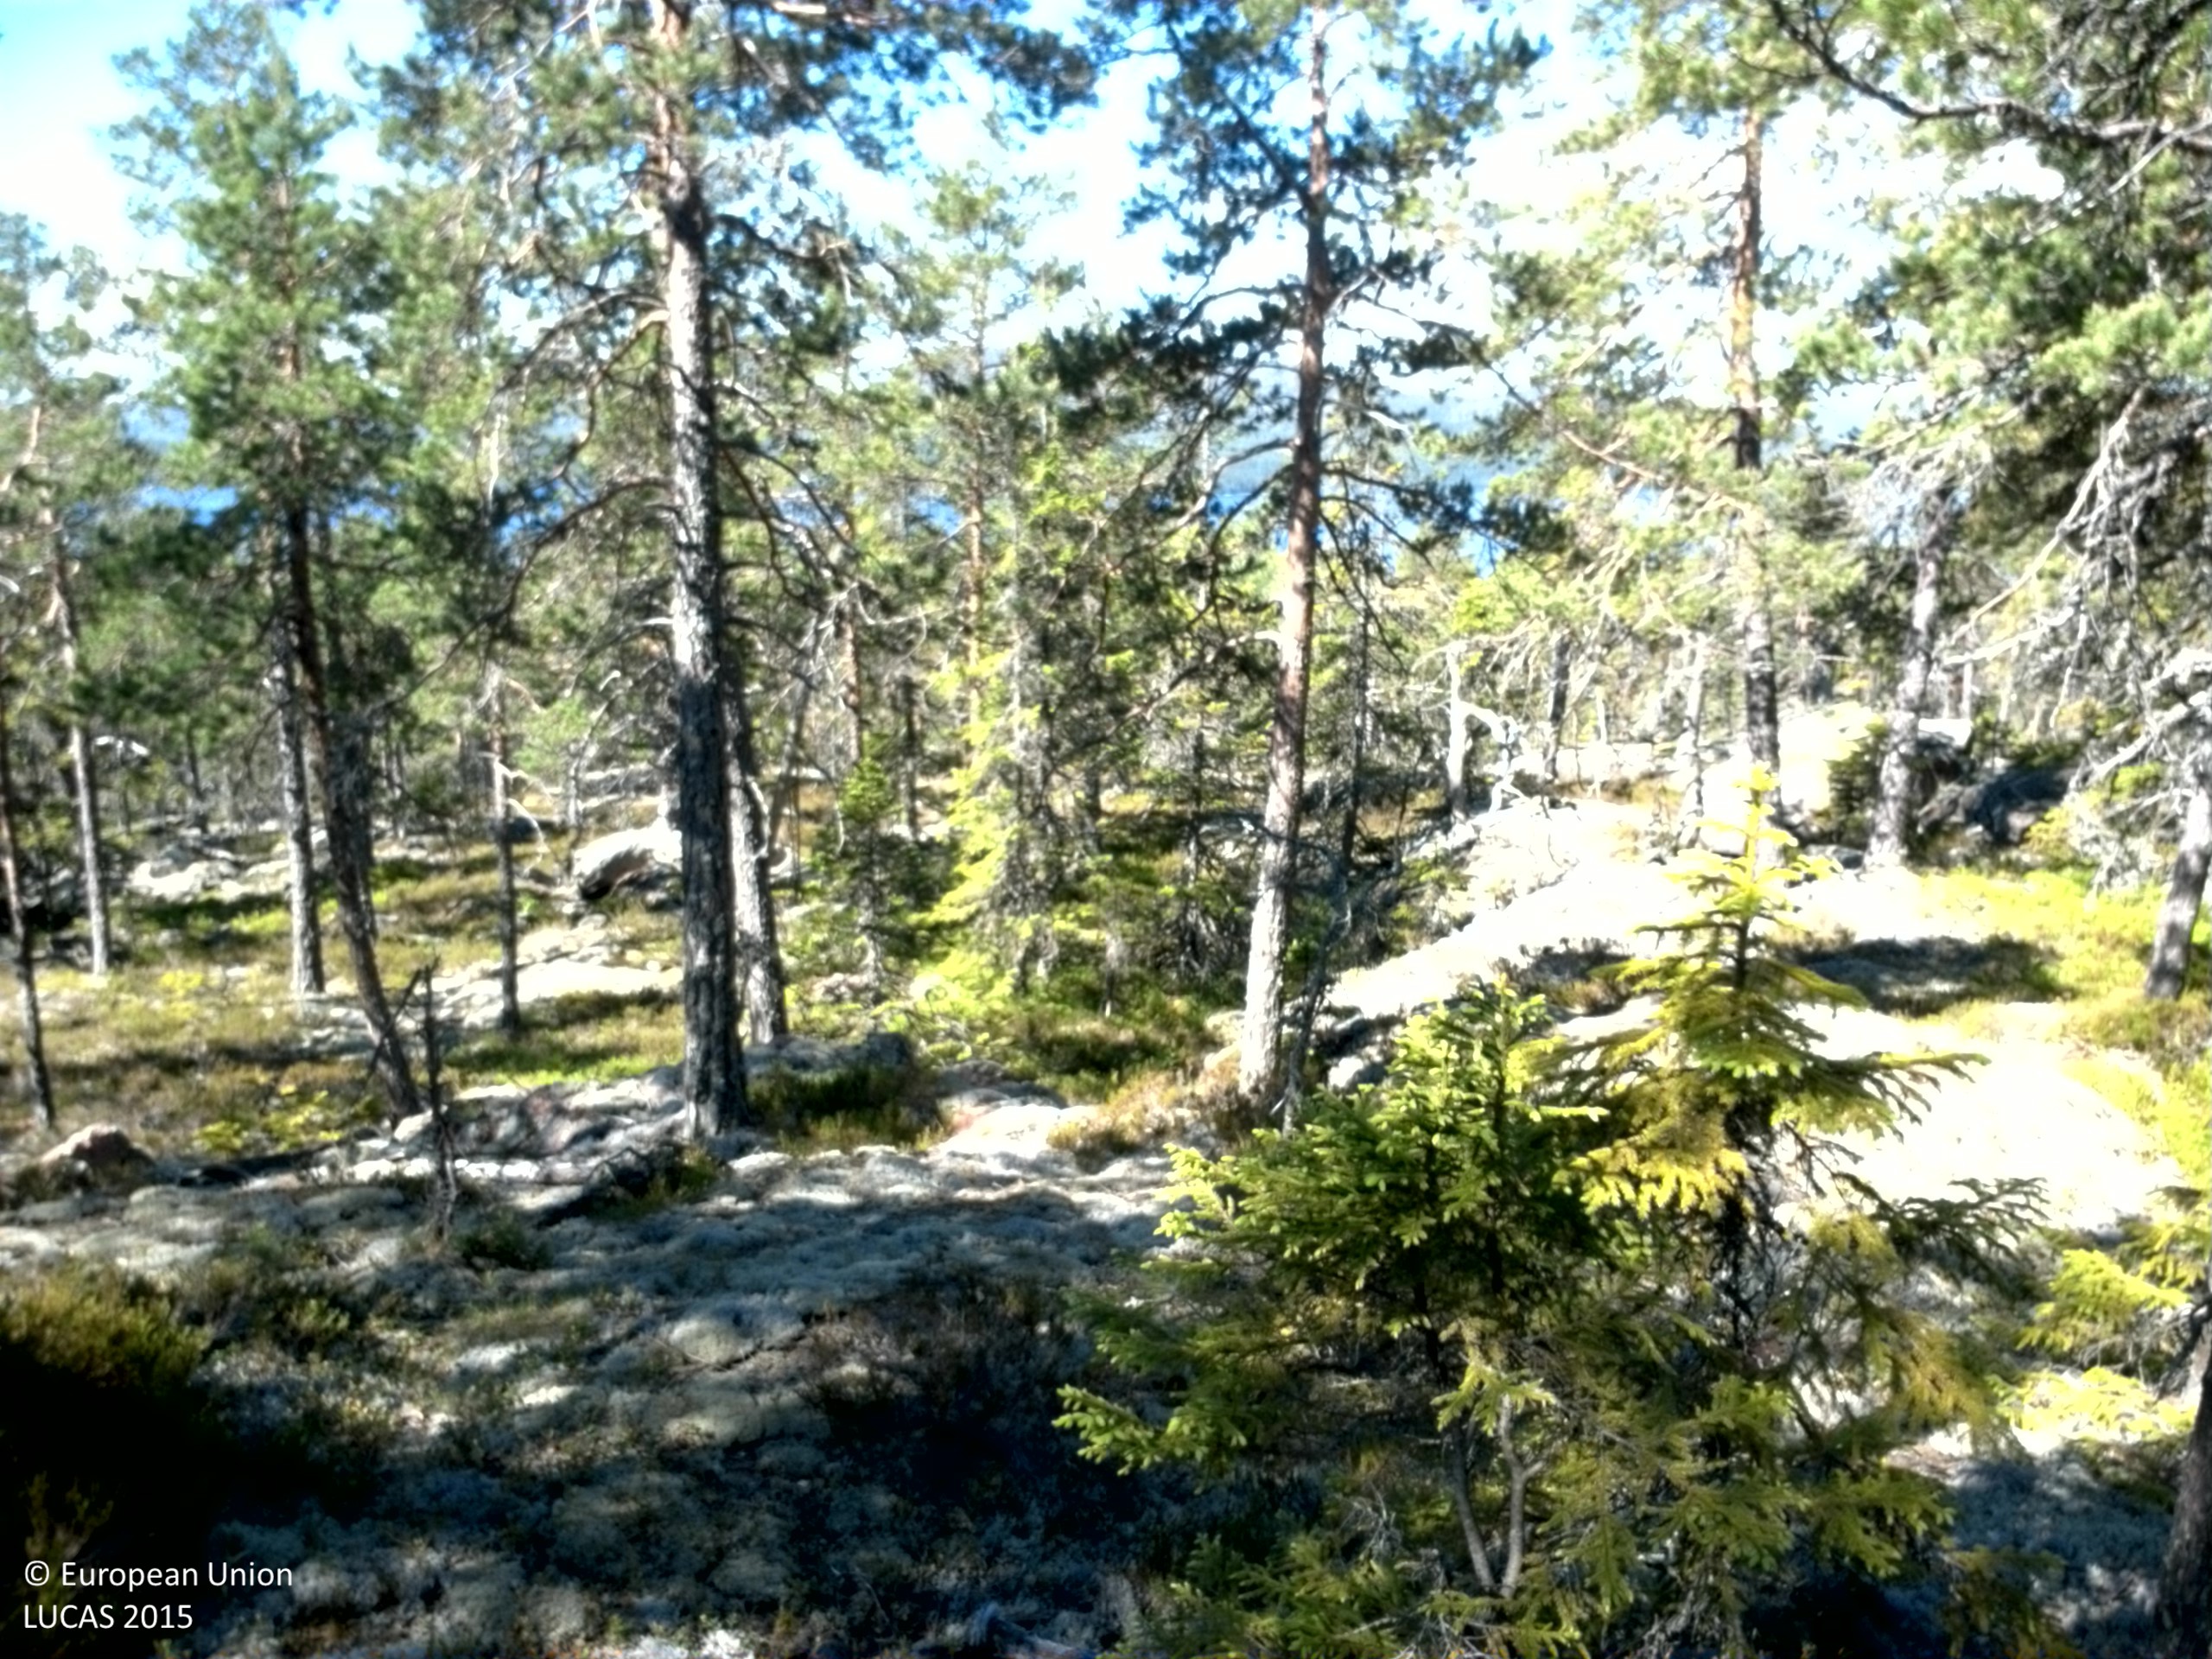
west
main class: Woodland
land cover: Pine dominated coniferous woodland
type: boreal forest
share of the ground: 50 - 75 %
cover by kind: coniferous forest trees 45 %, lichens and mosses 35 %, shrubs 10 %, consolidated bare surface 10 %
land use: Semi-natural and natural areas not in use
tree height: > 5 m
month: June
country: SE
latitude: 63.0457
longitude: 18.4624
